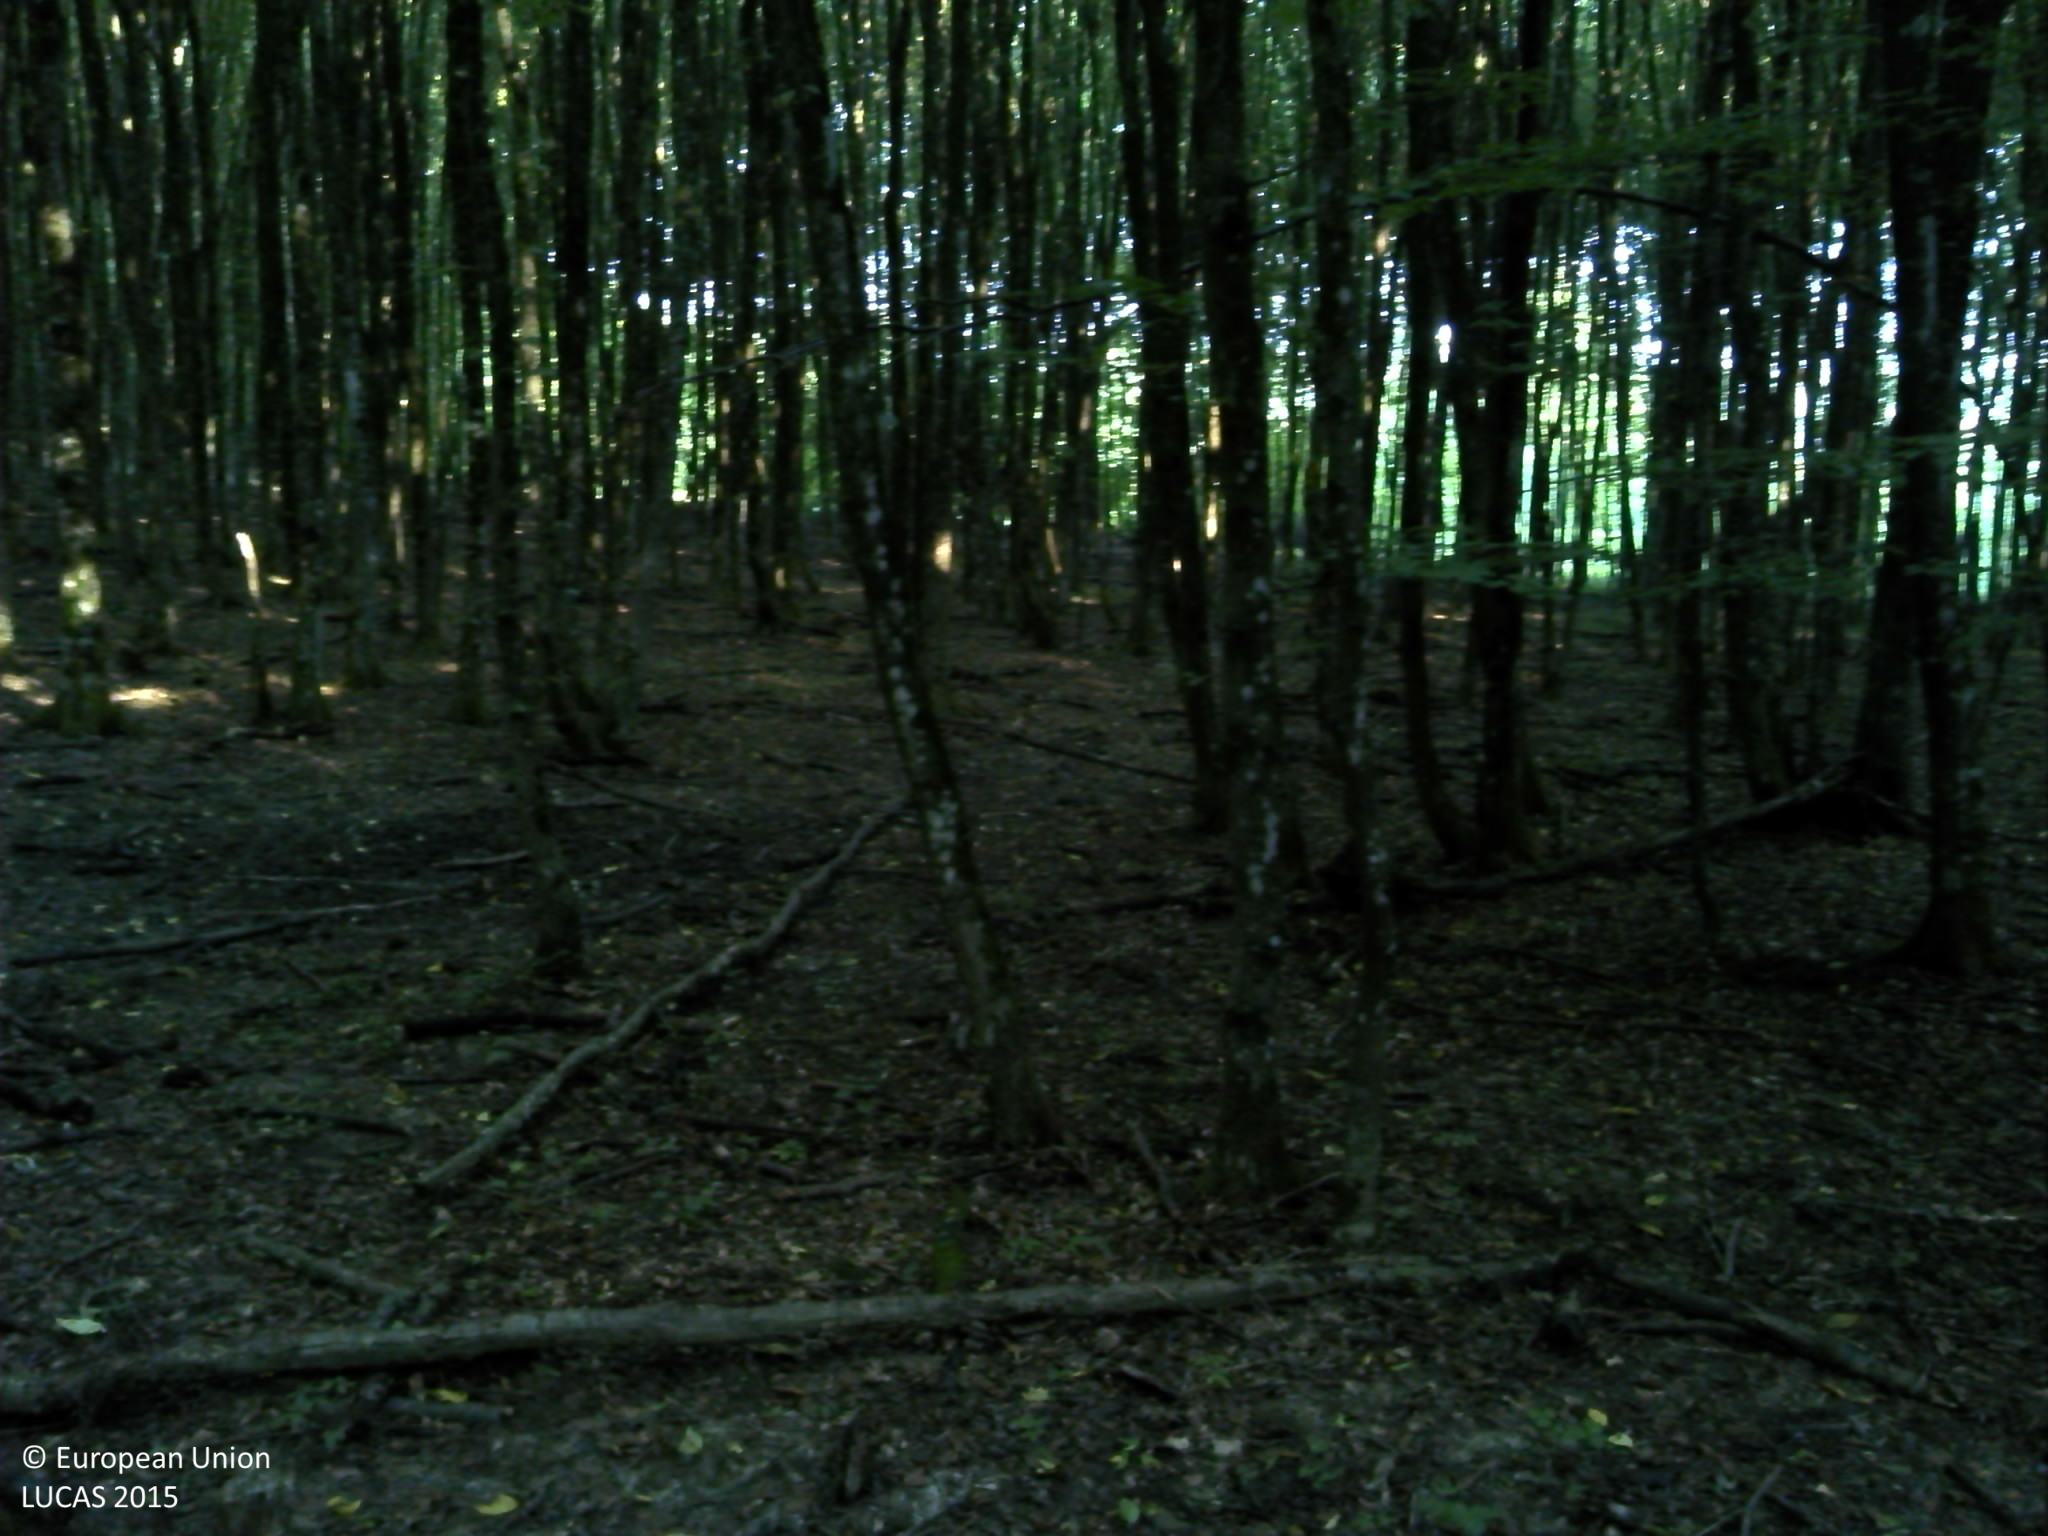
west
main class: Woodland
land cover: Broadleaved woodland
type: beech forest
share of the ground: > 75 %
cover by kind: broadleaved forest trees 100 %
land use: Forestry
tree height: > 5 m
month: August
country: HR
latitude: 45.7048
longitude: 17.2841
